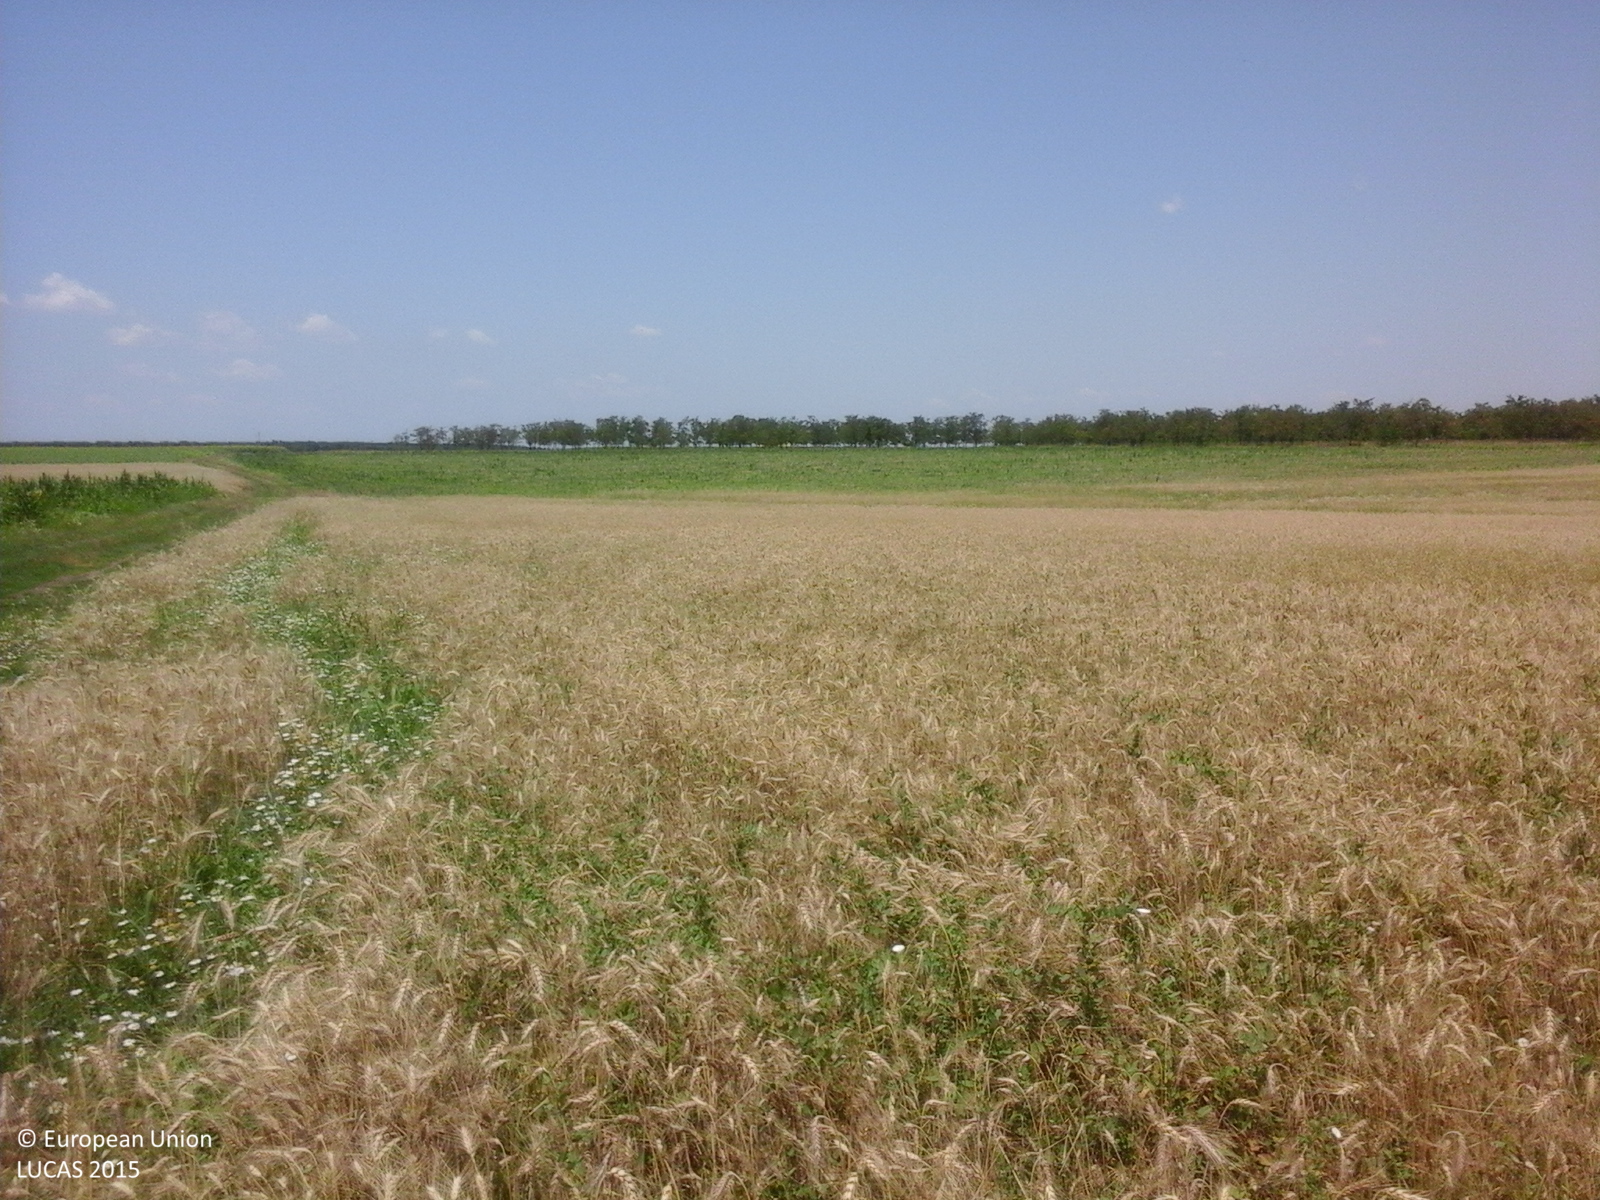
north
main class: Cropland
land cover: Common wheat
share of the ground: > 75 %
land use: Agriculture (excluding fallow land and kitchen gardens)
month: July
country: RO
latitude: 44.4271
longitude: 24.6059
